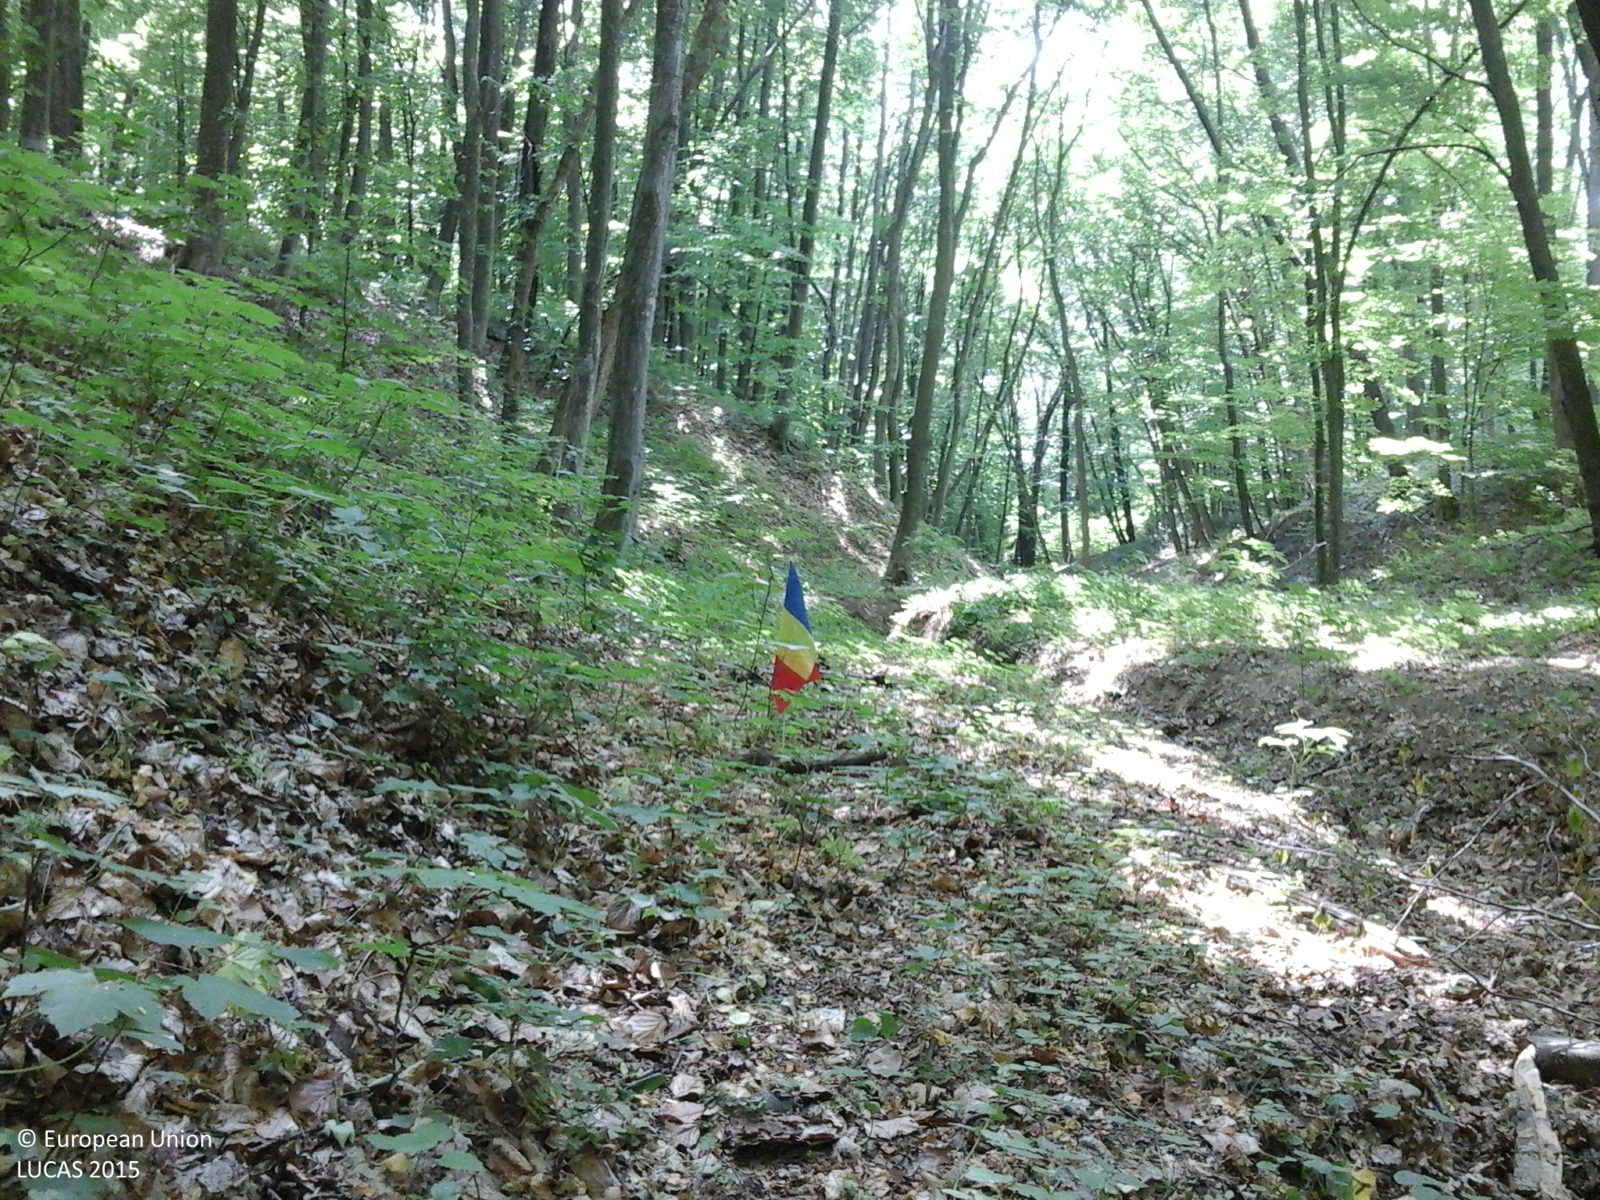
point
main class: Woodland
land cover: Broadleaved woodland
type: beech forest
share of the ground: > 75 %
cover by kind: broadleaved forest trees 100 %
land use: Forestry
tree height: > 5 m
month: June
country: RO
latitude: 46.9055
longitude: 26.6703
